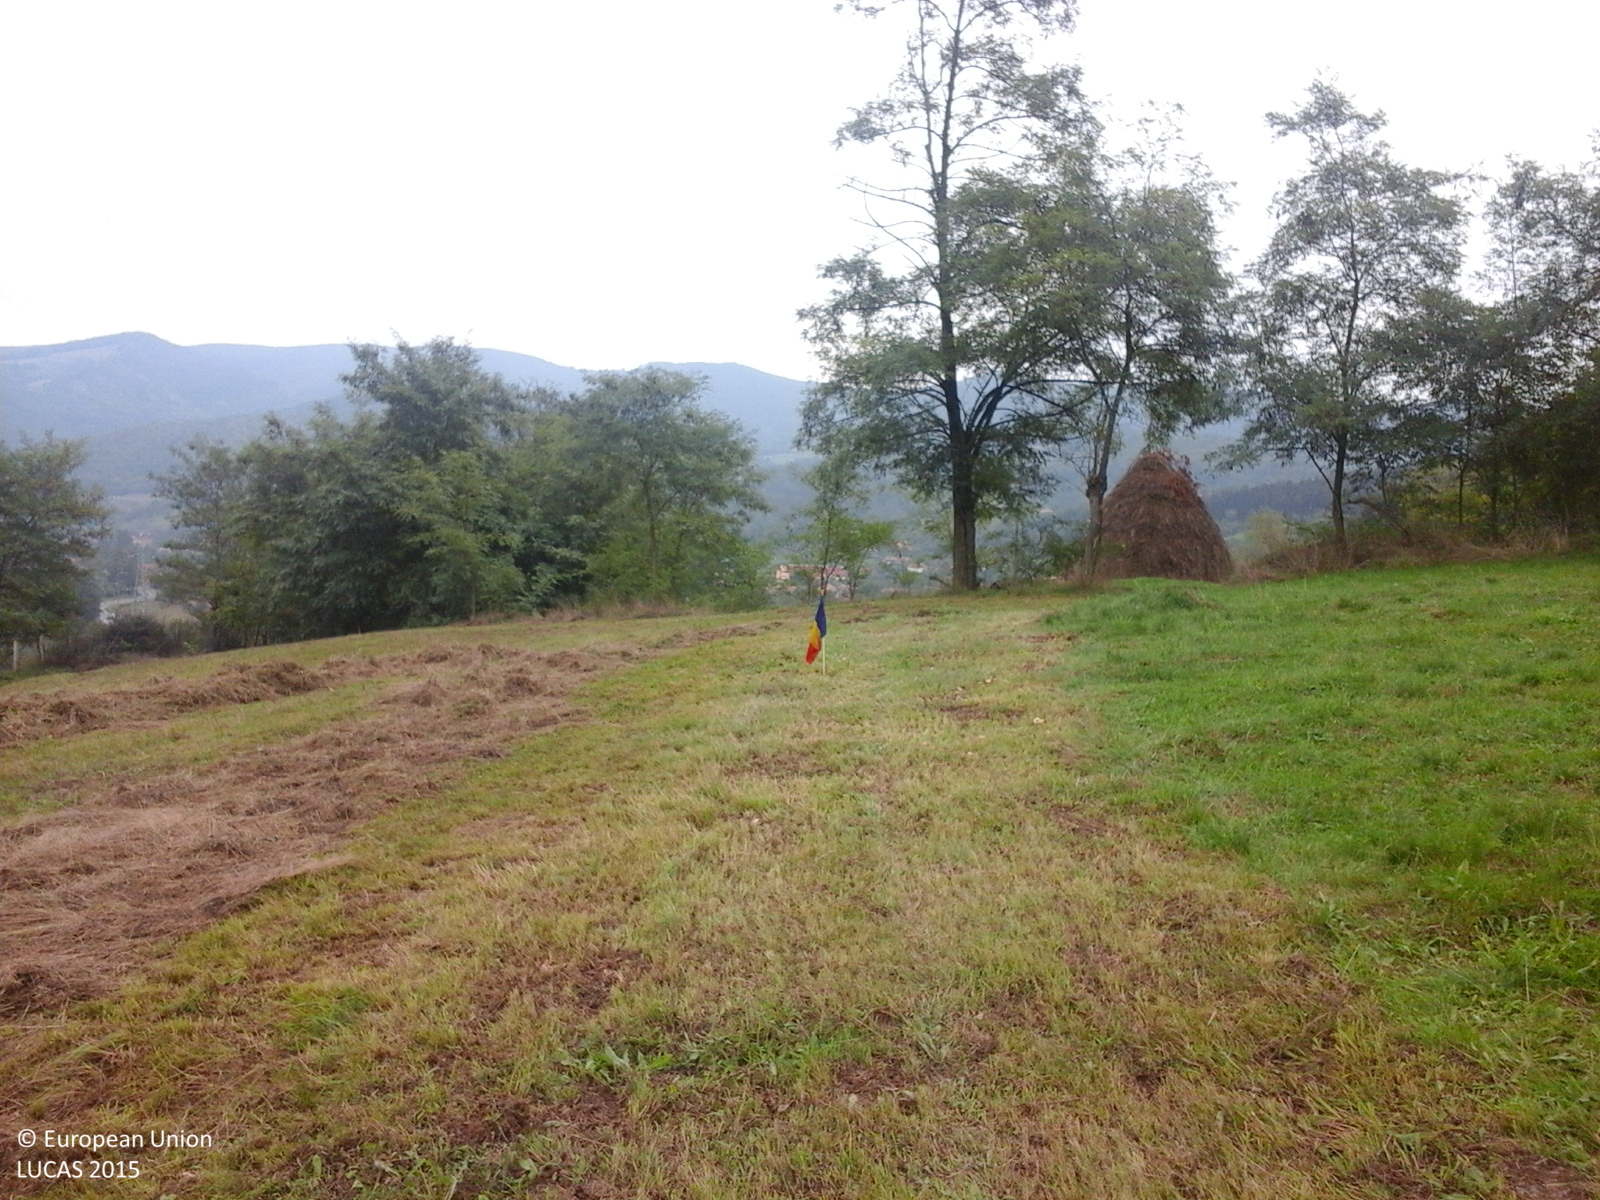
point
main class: Grassland
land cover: Grassland without tree/shrub cover
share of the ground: > 75 %
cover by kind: herbaceous plants 100 %
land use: Agriculture (excluding fallow land and kitchen gardens)
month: October
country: RO
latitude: 46.0990
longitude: 23.4526
